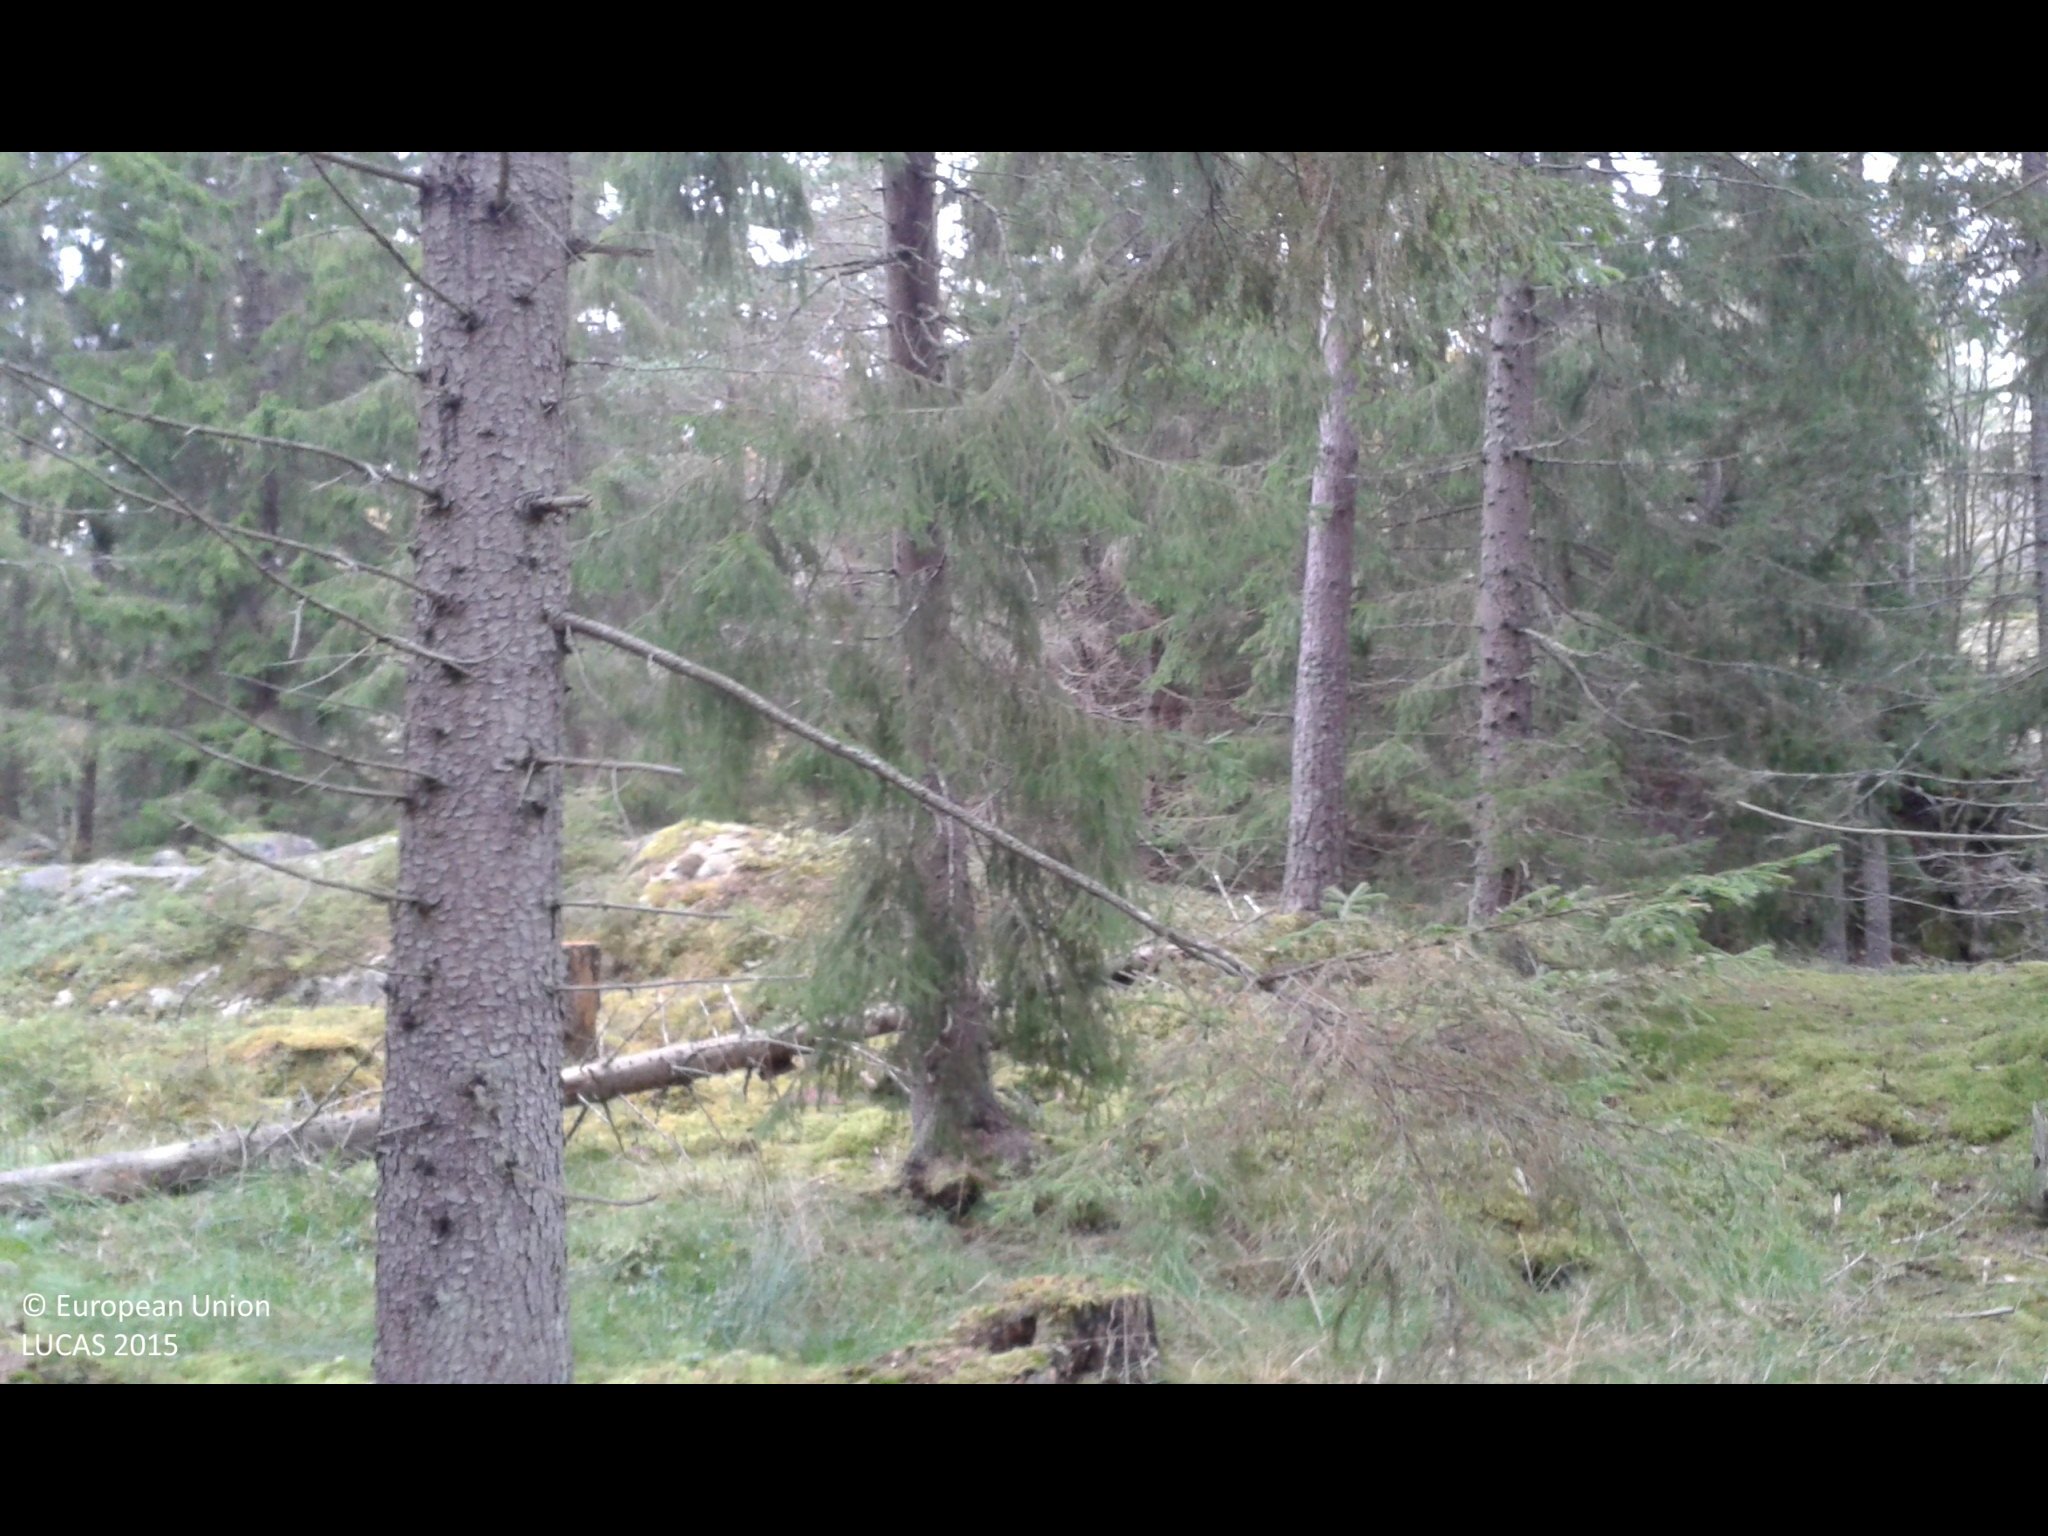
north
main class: Woodland
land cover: Spruce dominated coniferous woodland
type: boreal forest
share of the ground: 50 - 75 %
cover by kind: coniferous forest trees 70 %, herbaceous plants 30 %
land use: Forestry
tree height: > 5 m
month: October
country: SE
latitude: 58.7830
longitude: 17.2456
